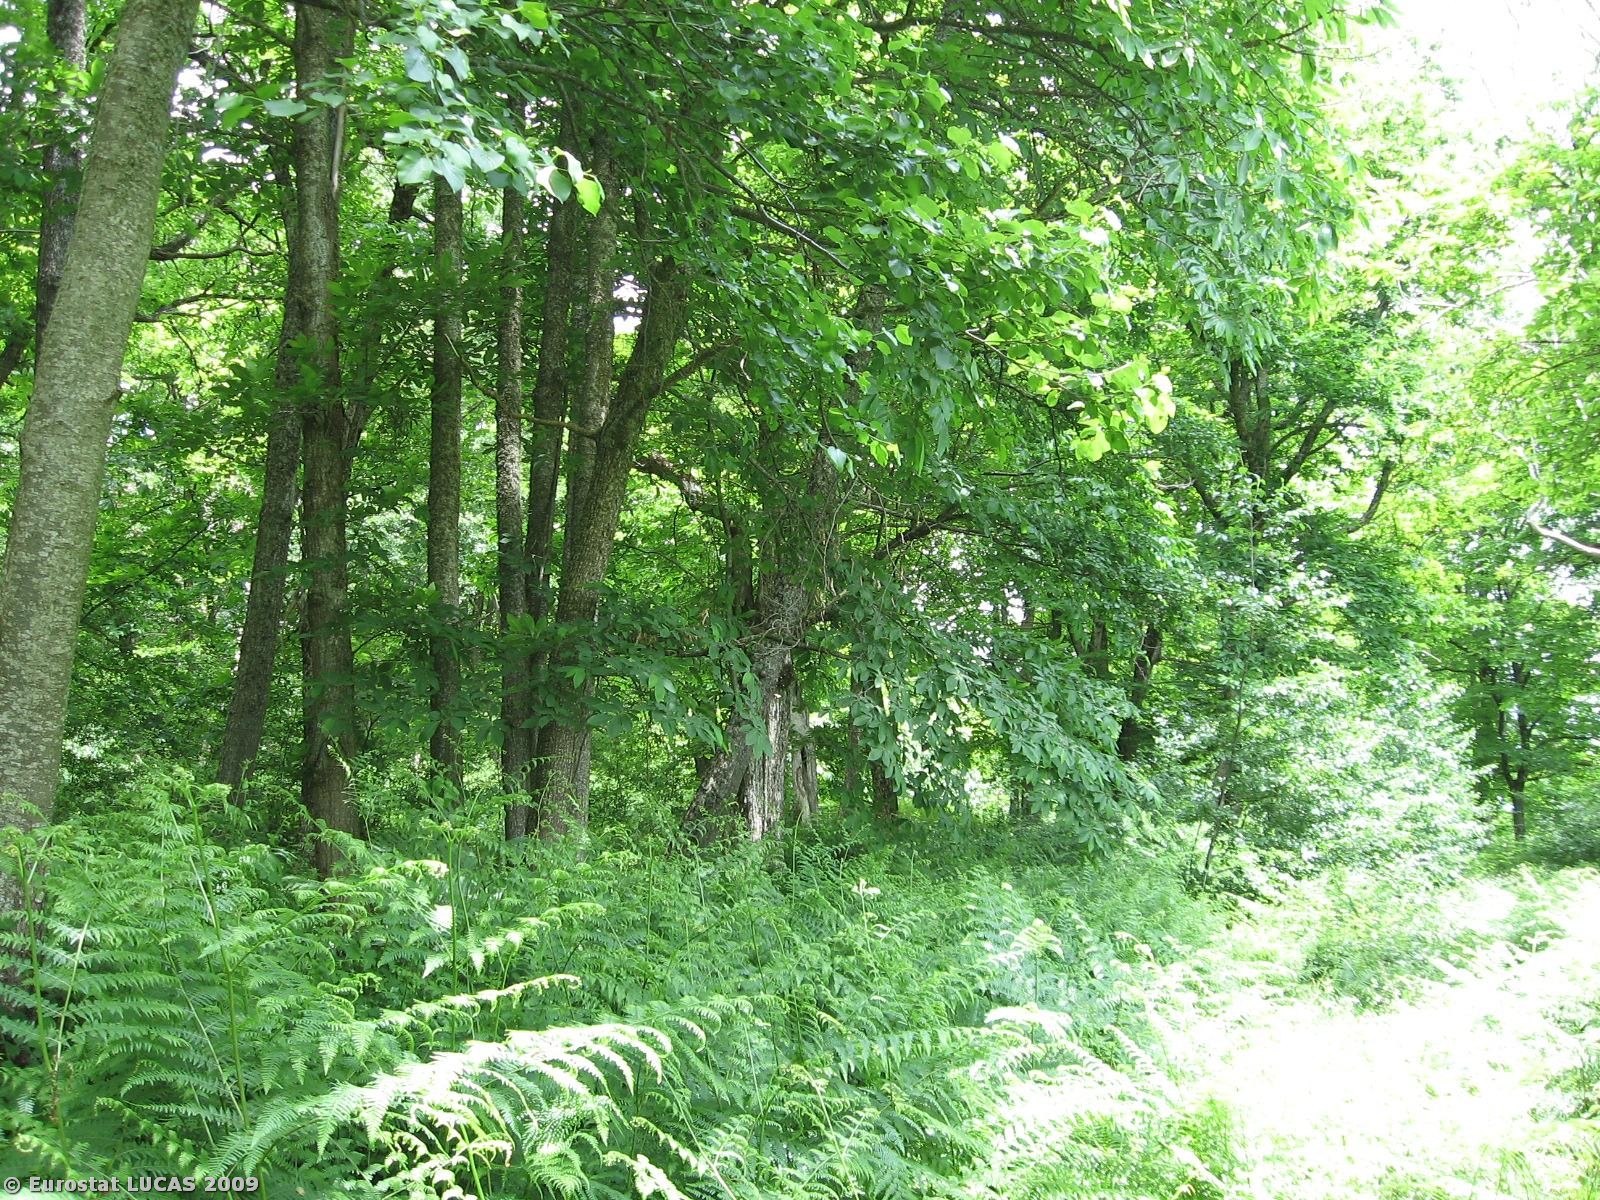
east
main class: Woodland
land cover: Broadleaved woodland
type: thermophilous deciduous forest
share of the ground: > 75 %
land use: Agriculture (excluding fallow land and kitchen gardens)
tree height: > 5 m
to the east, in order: Broadleaved woodland
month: June
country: IT
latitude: 38.9853
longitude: 16.4202
